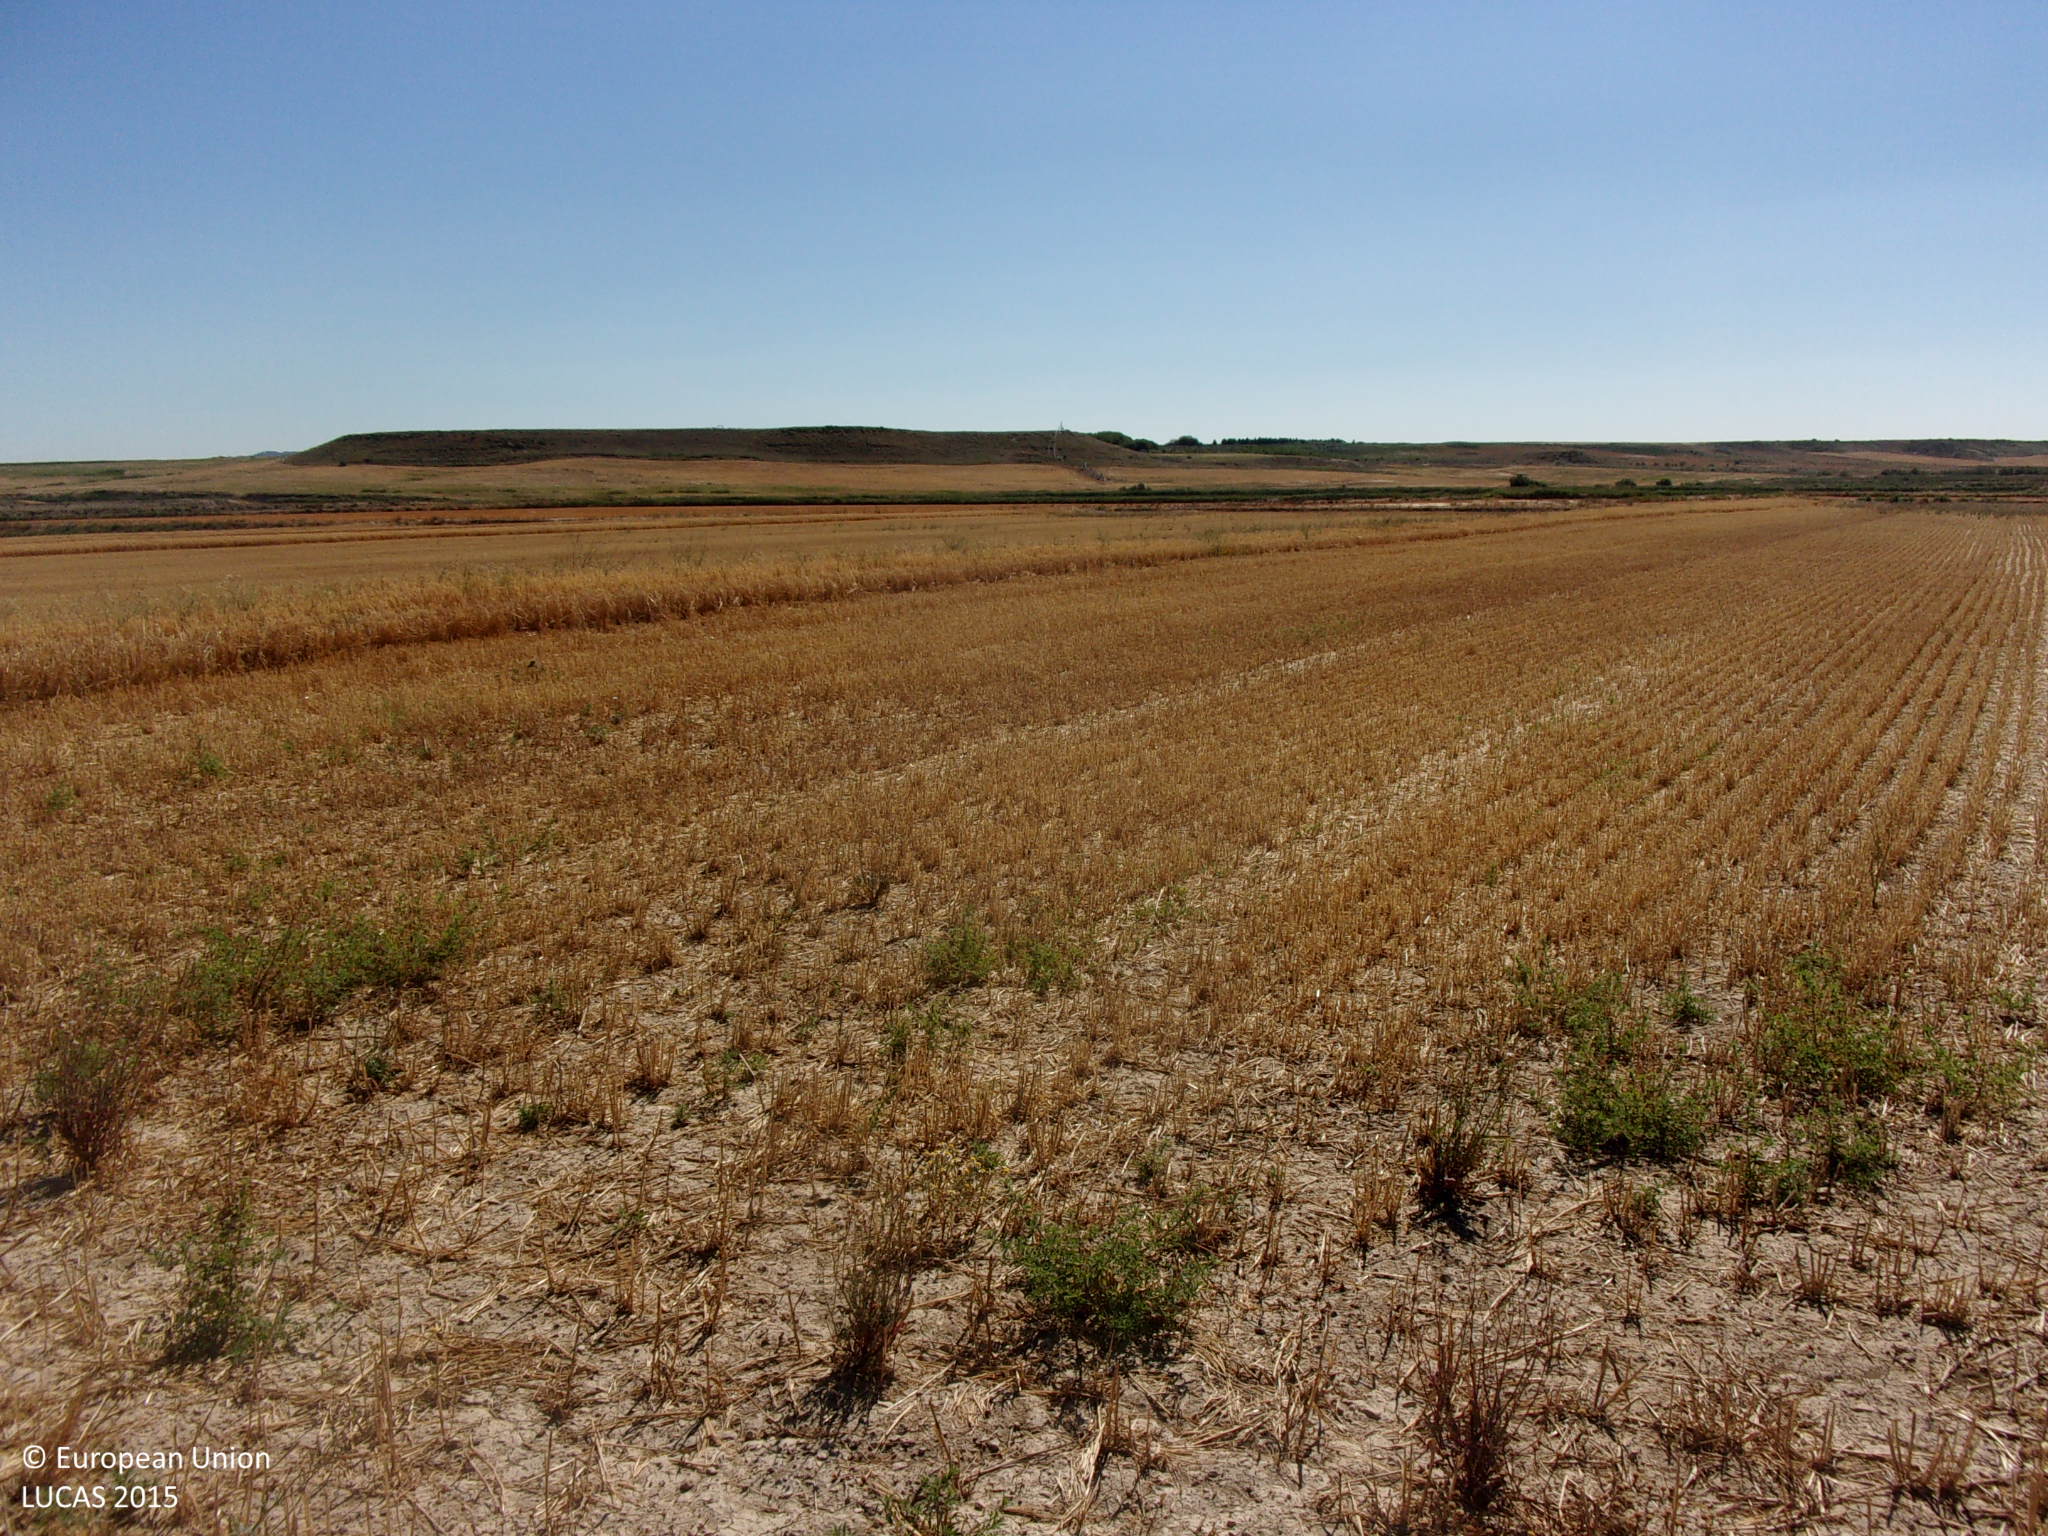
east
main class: Cropland
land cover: Barley
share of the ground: < 10 %
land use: Agriculture (excluding fallow land and kitchen gardens)
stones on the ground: < 10 %
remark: Harvested field
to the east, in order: Barley; Grass margins; Barley; Grass margins; Tracks; Grass margins; Barley; Grass margins; Barley
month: July
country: ES
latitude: 42.0851
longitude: -1.0400
